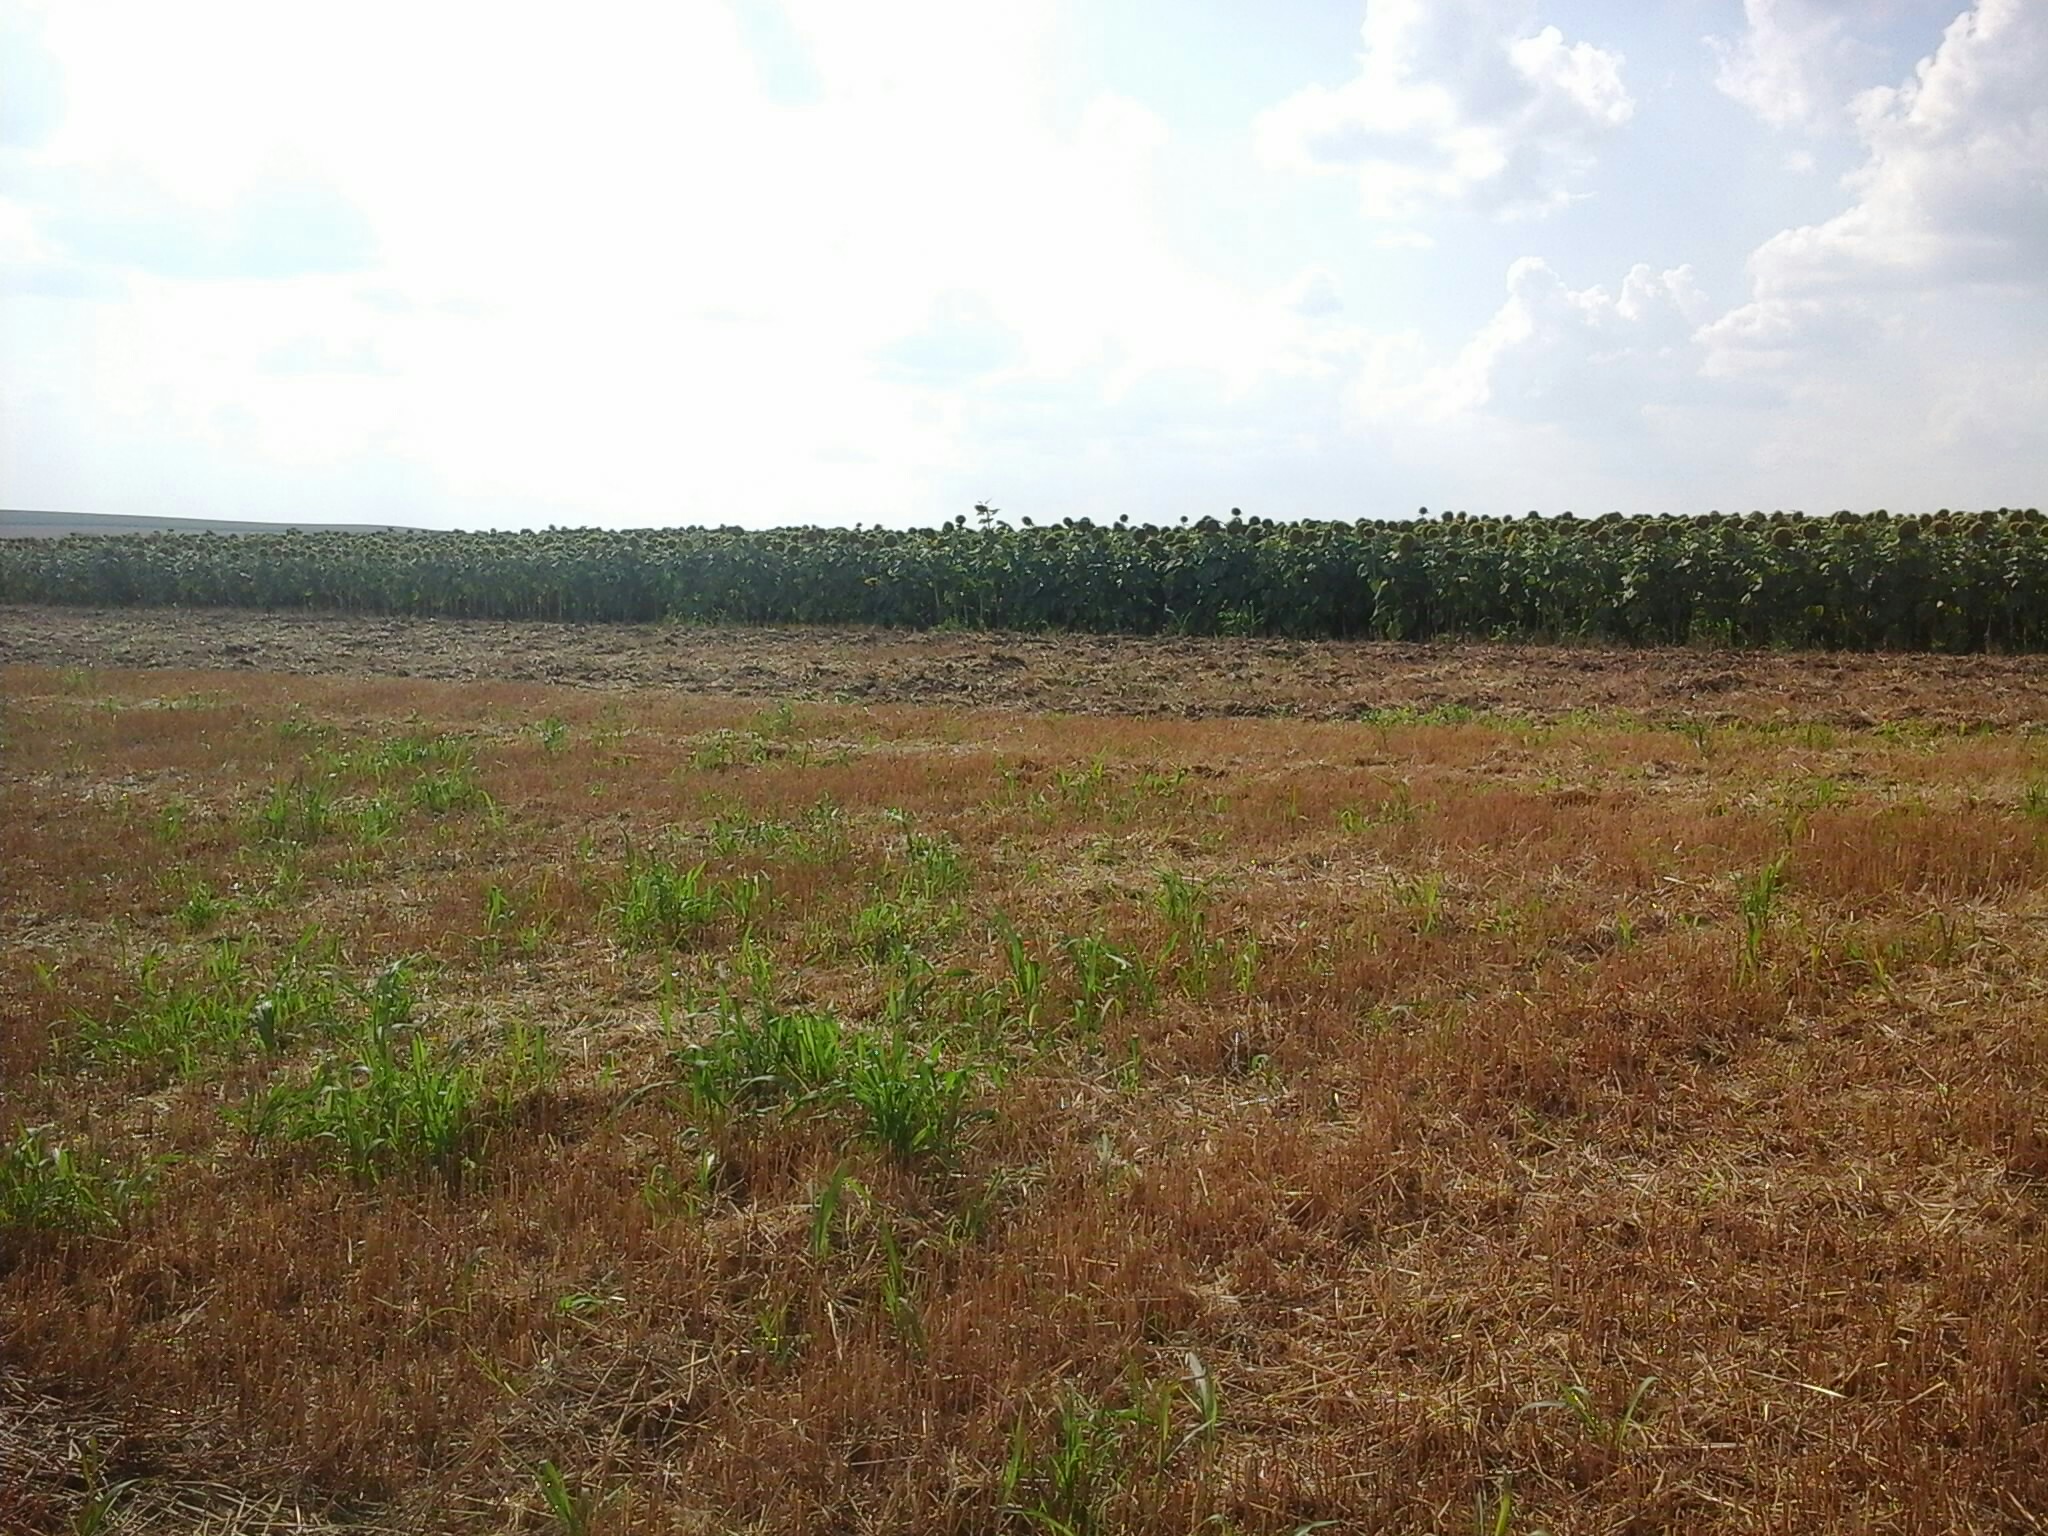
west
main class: Cropland
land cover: Common wheat
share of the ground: > 75 %
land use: Agriculture (excluding fallow land and kitchen gardens)
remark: Harvested field
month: August
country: HU
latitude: 47.5730
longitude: 18.2144
